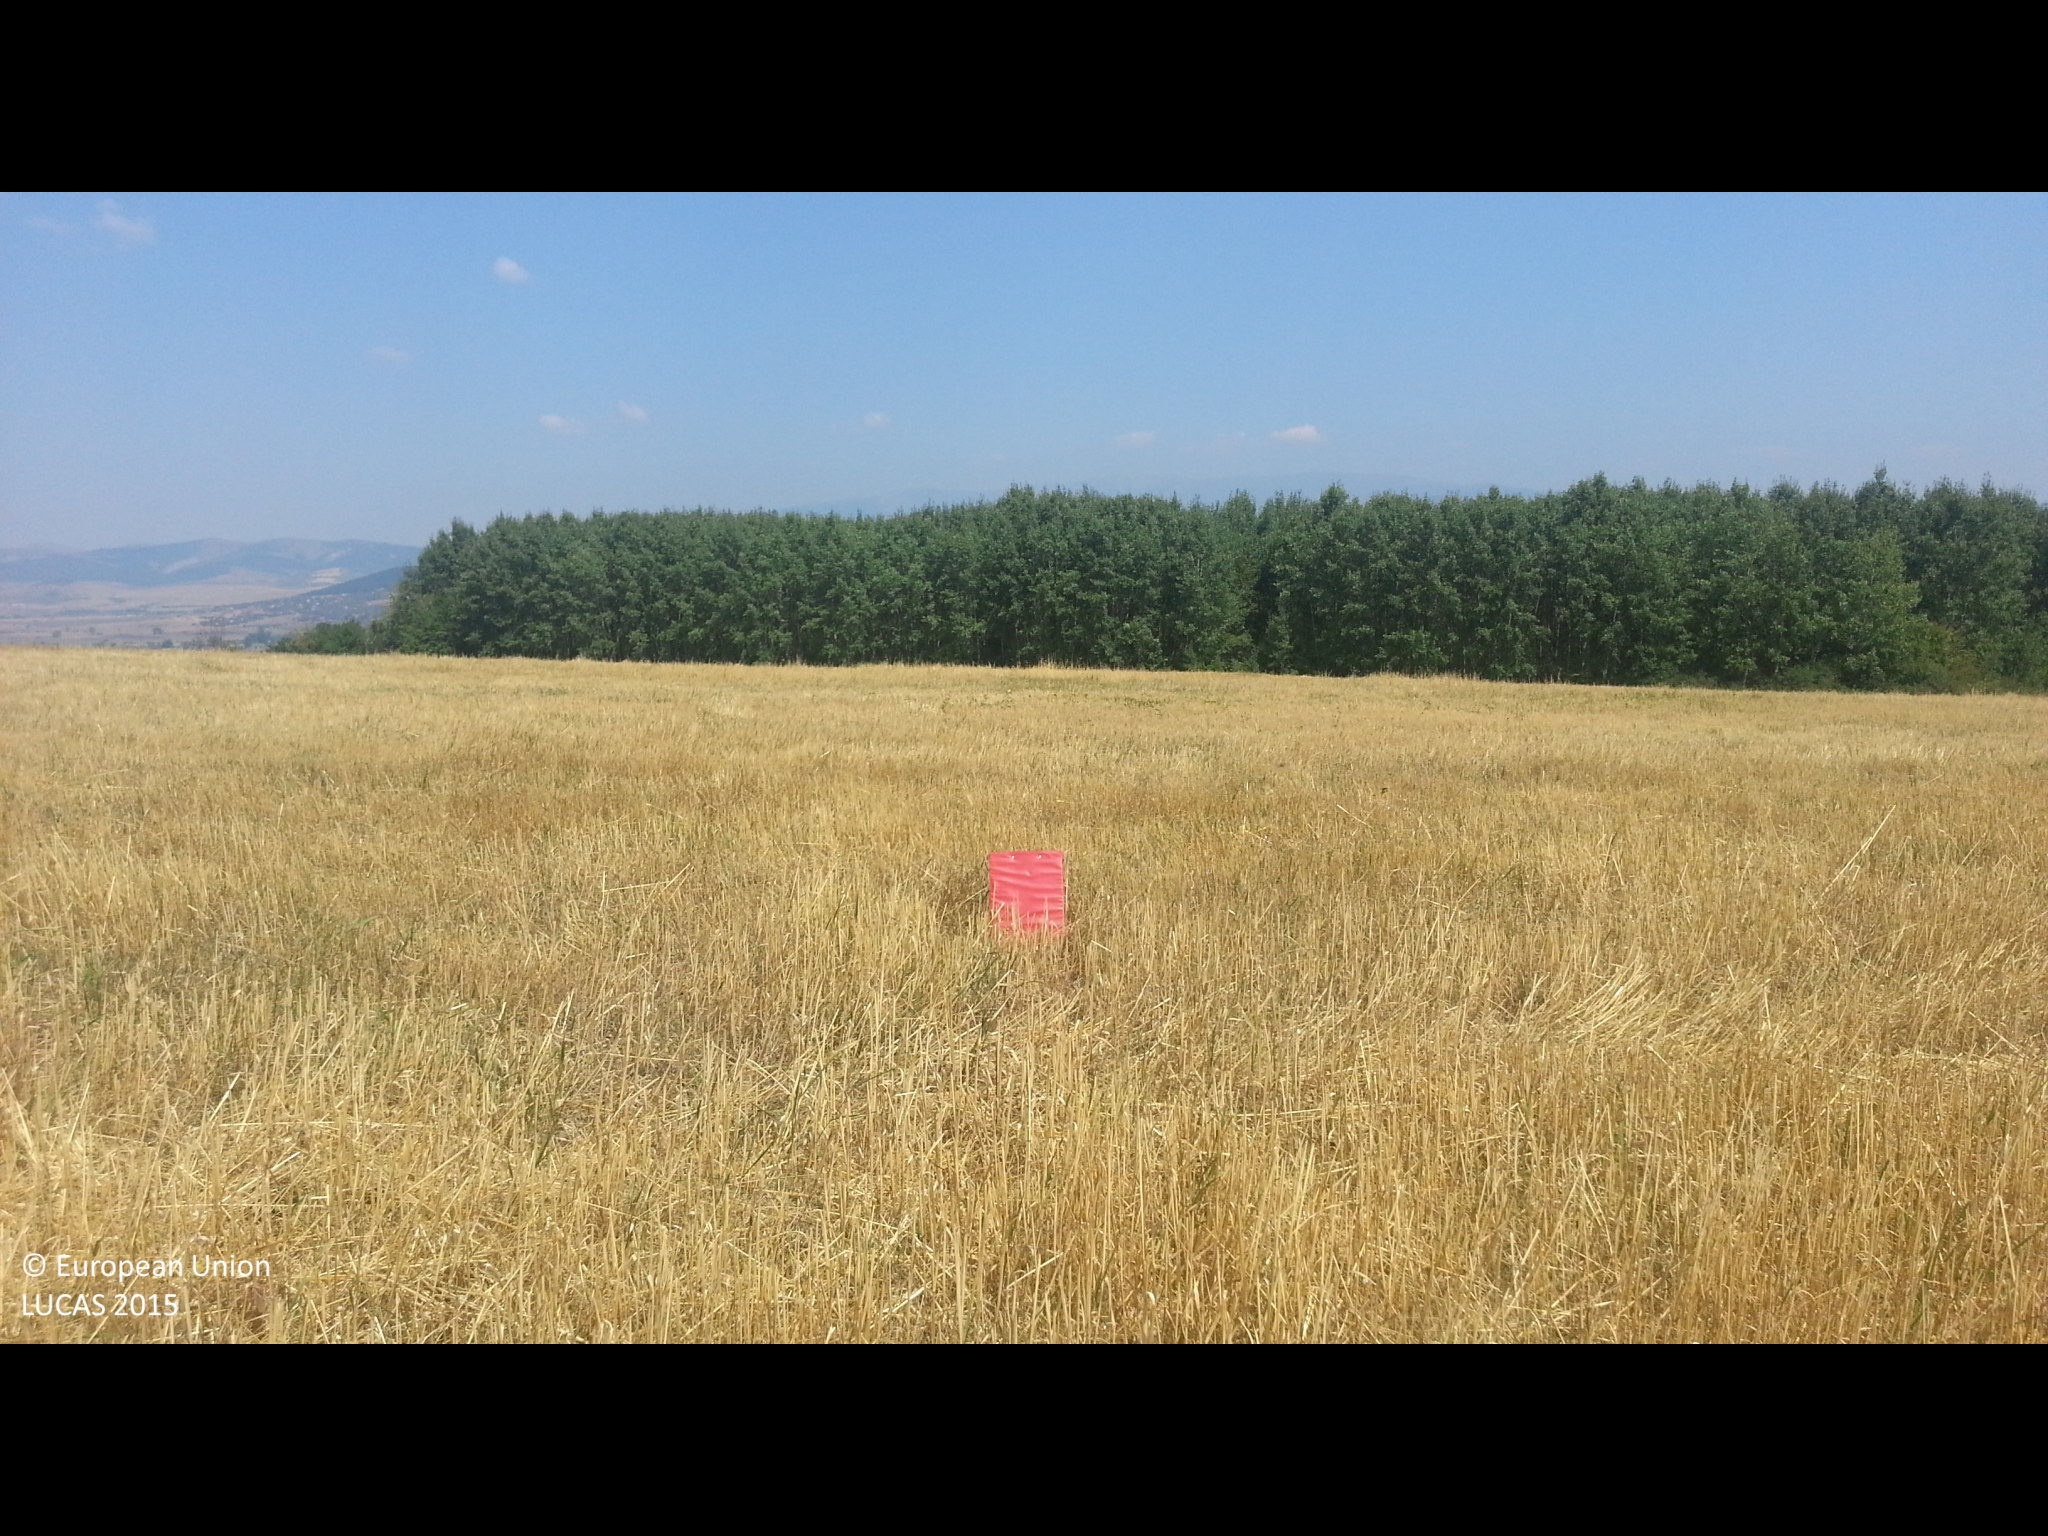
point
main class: Cropland
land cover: Common wheat
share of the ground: > 75 %
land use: Agriculture (excluding fallow land and kitchen gardens)
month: August
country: BG
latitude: 42.3889
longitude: 23.0613
